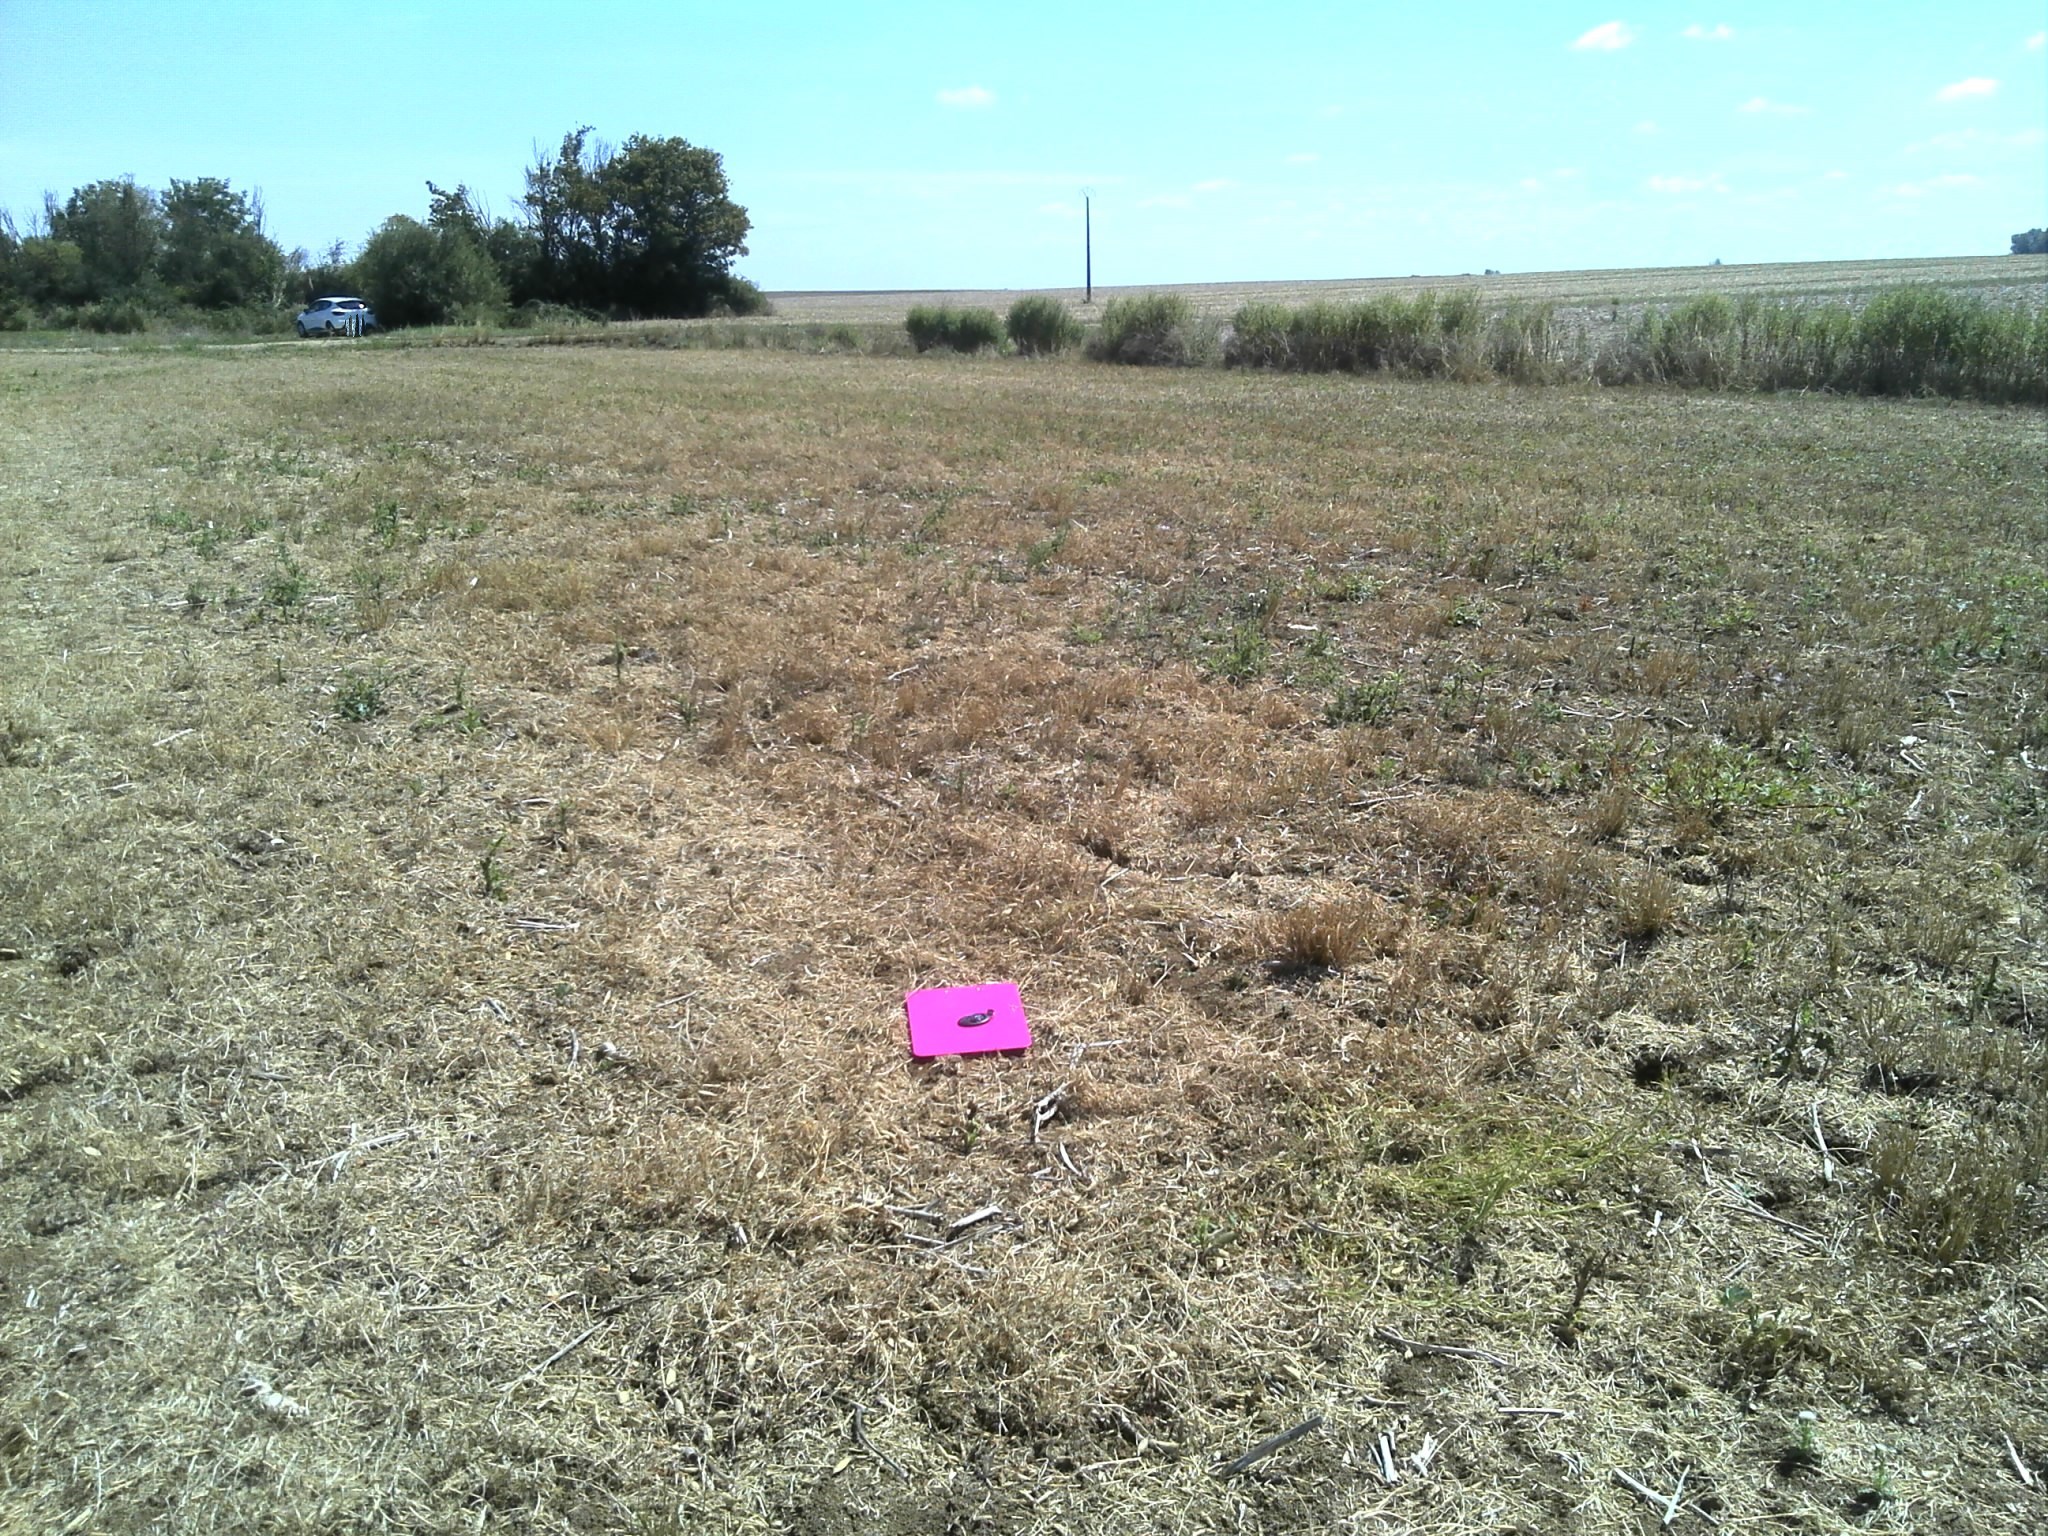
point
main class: Cropland
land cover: Dry pulses
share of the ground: 25 - 50 %
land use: Agriculture (excluding fallow land and kitchen gardens)
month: August
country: FR
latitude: 46.9507
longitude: 1.4605
